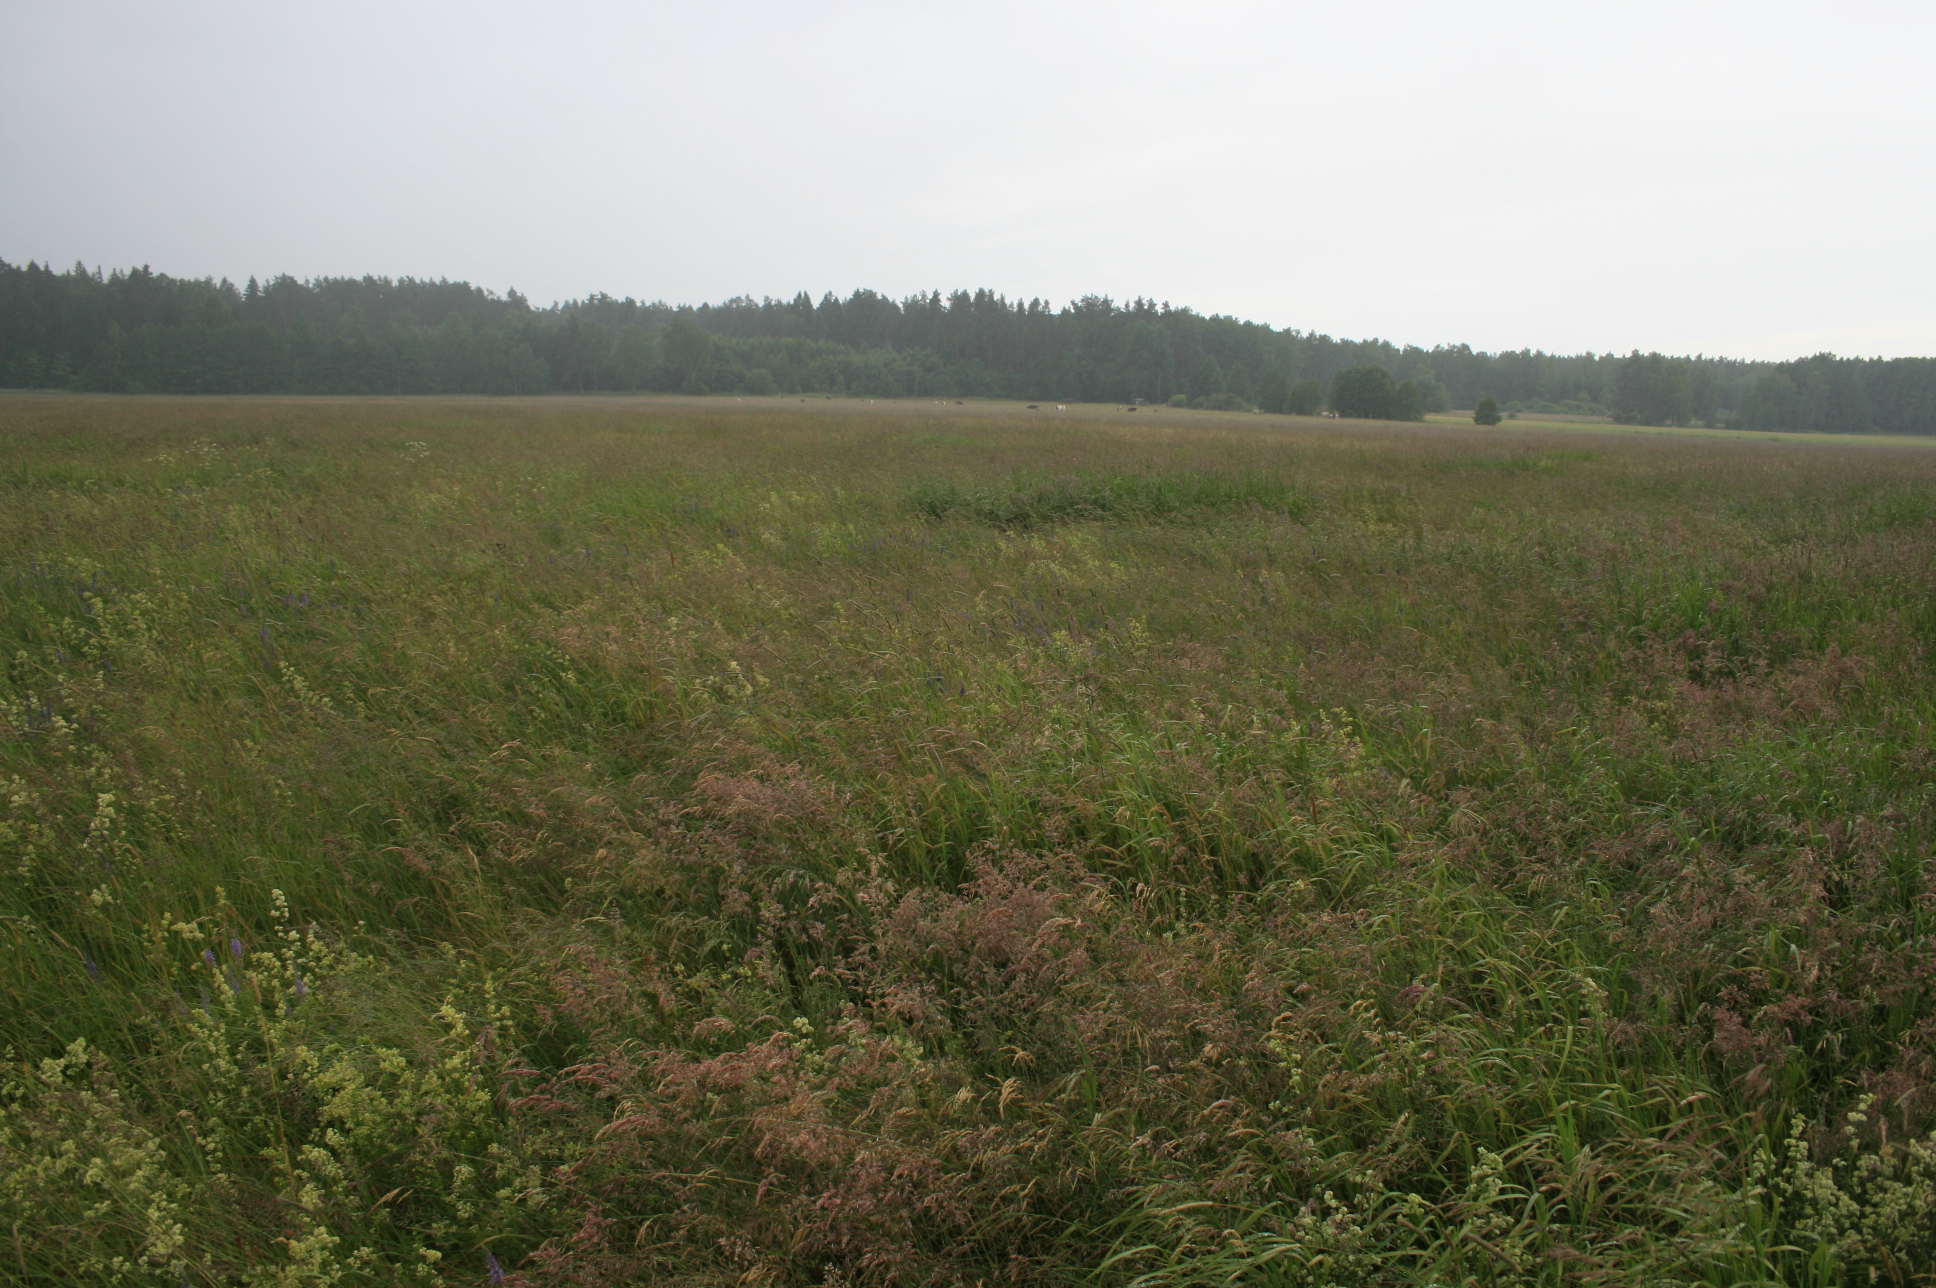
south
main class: Grassland
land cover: Grassland without tree/shrub cover
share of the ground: > 75 %
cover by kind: herbaceous plants 100 %
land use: Agriculture (excluding fallow land and kitchen gardens)
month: June
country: LT
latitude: 55.1078
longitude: 22.2375
